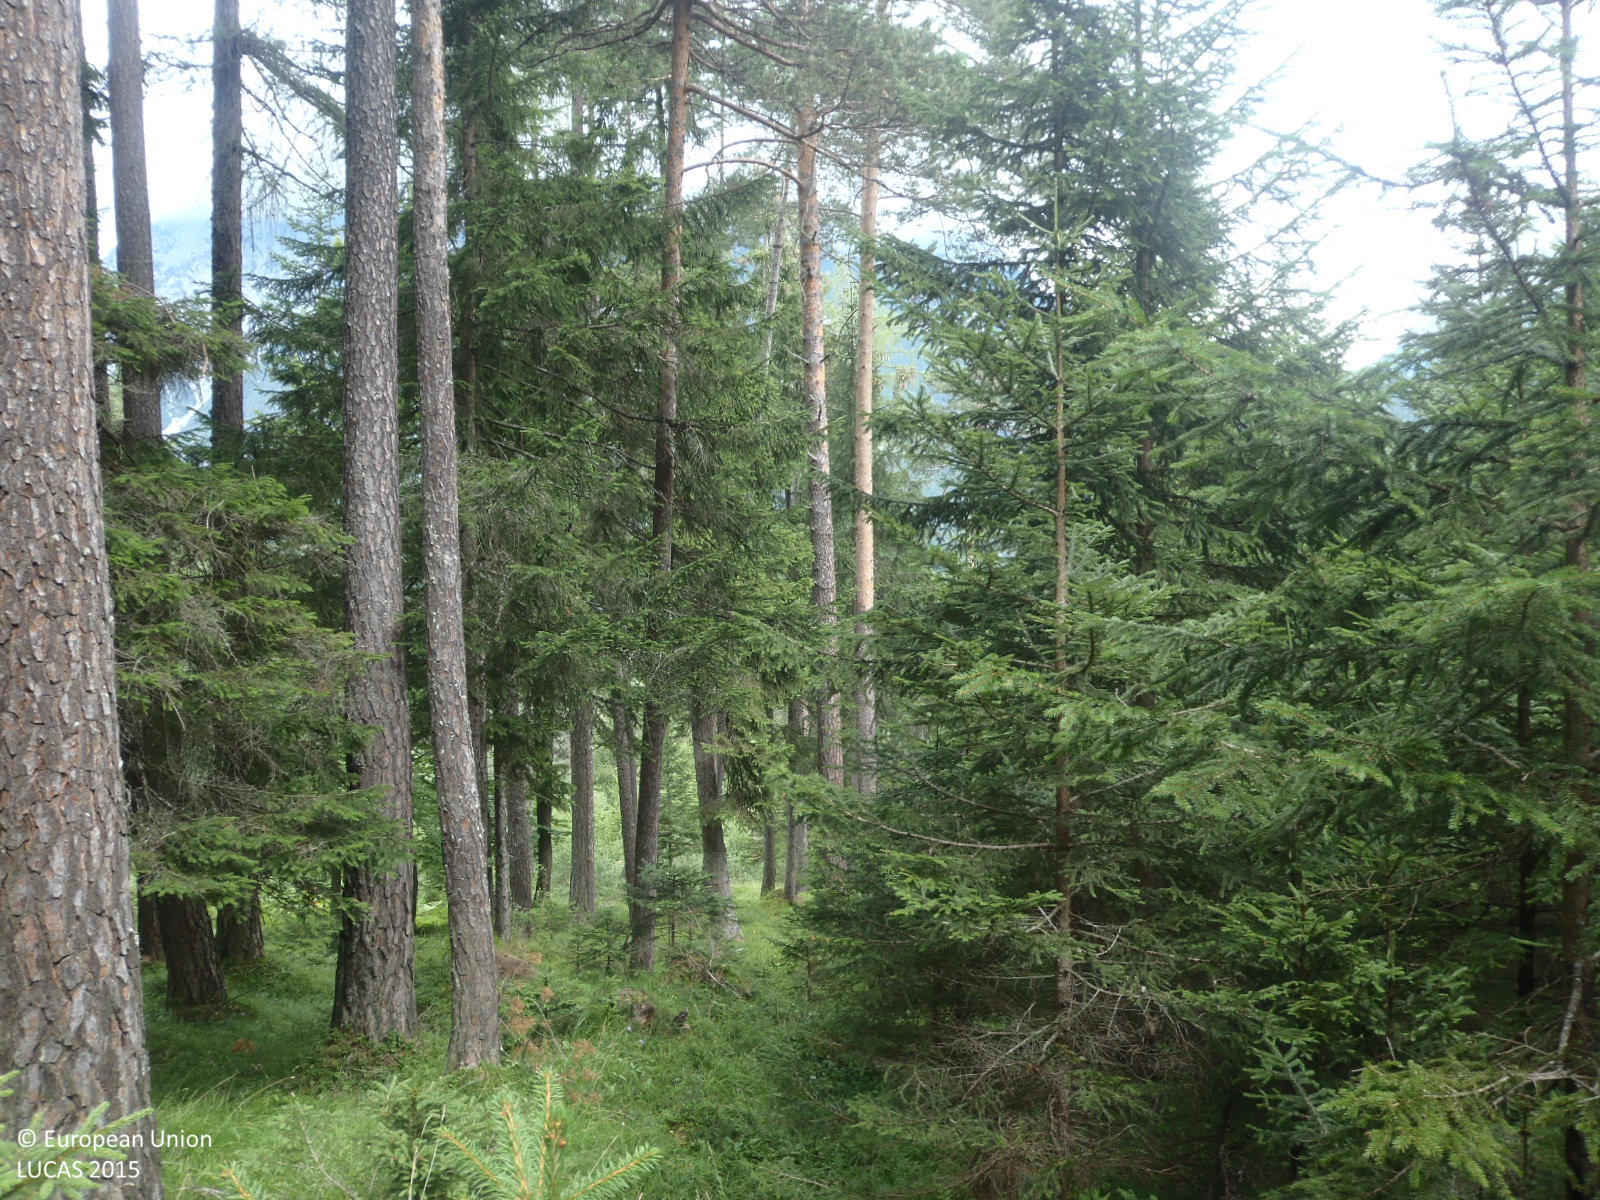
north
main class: Woodland
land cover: Other coniferous woodland
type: alpine coniferous forest
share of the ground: > 75 %
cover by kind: coniferous forest trees 80 %, herbaceous plants 15 %, shrubs 5 %
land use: Forestry
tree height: > 5 m
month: July
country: AT
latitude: 47.3020
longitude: 10.8853
